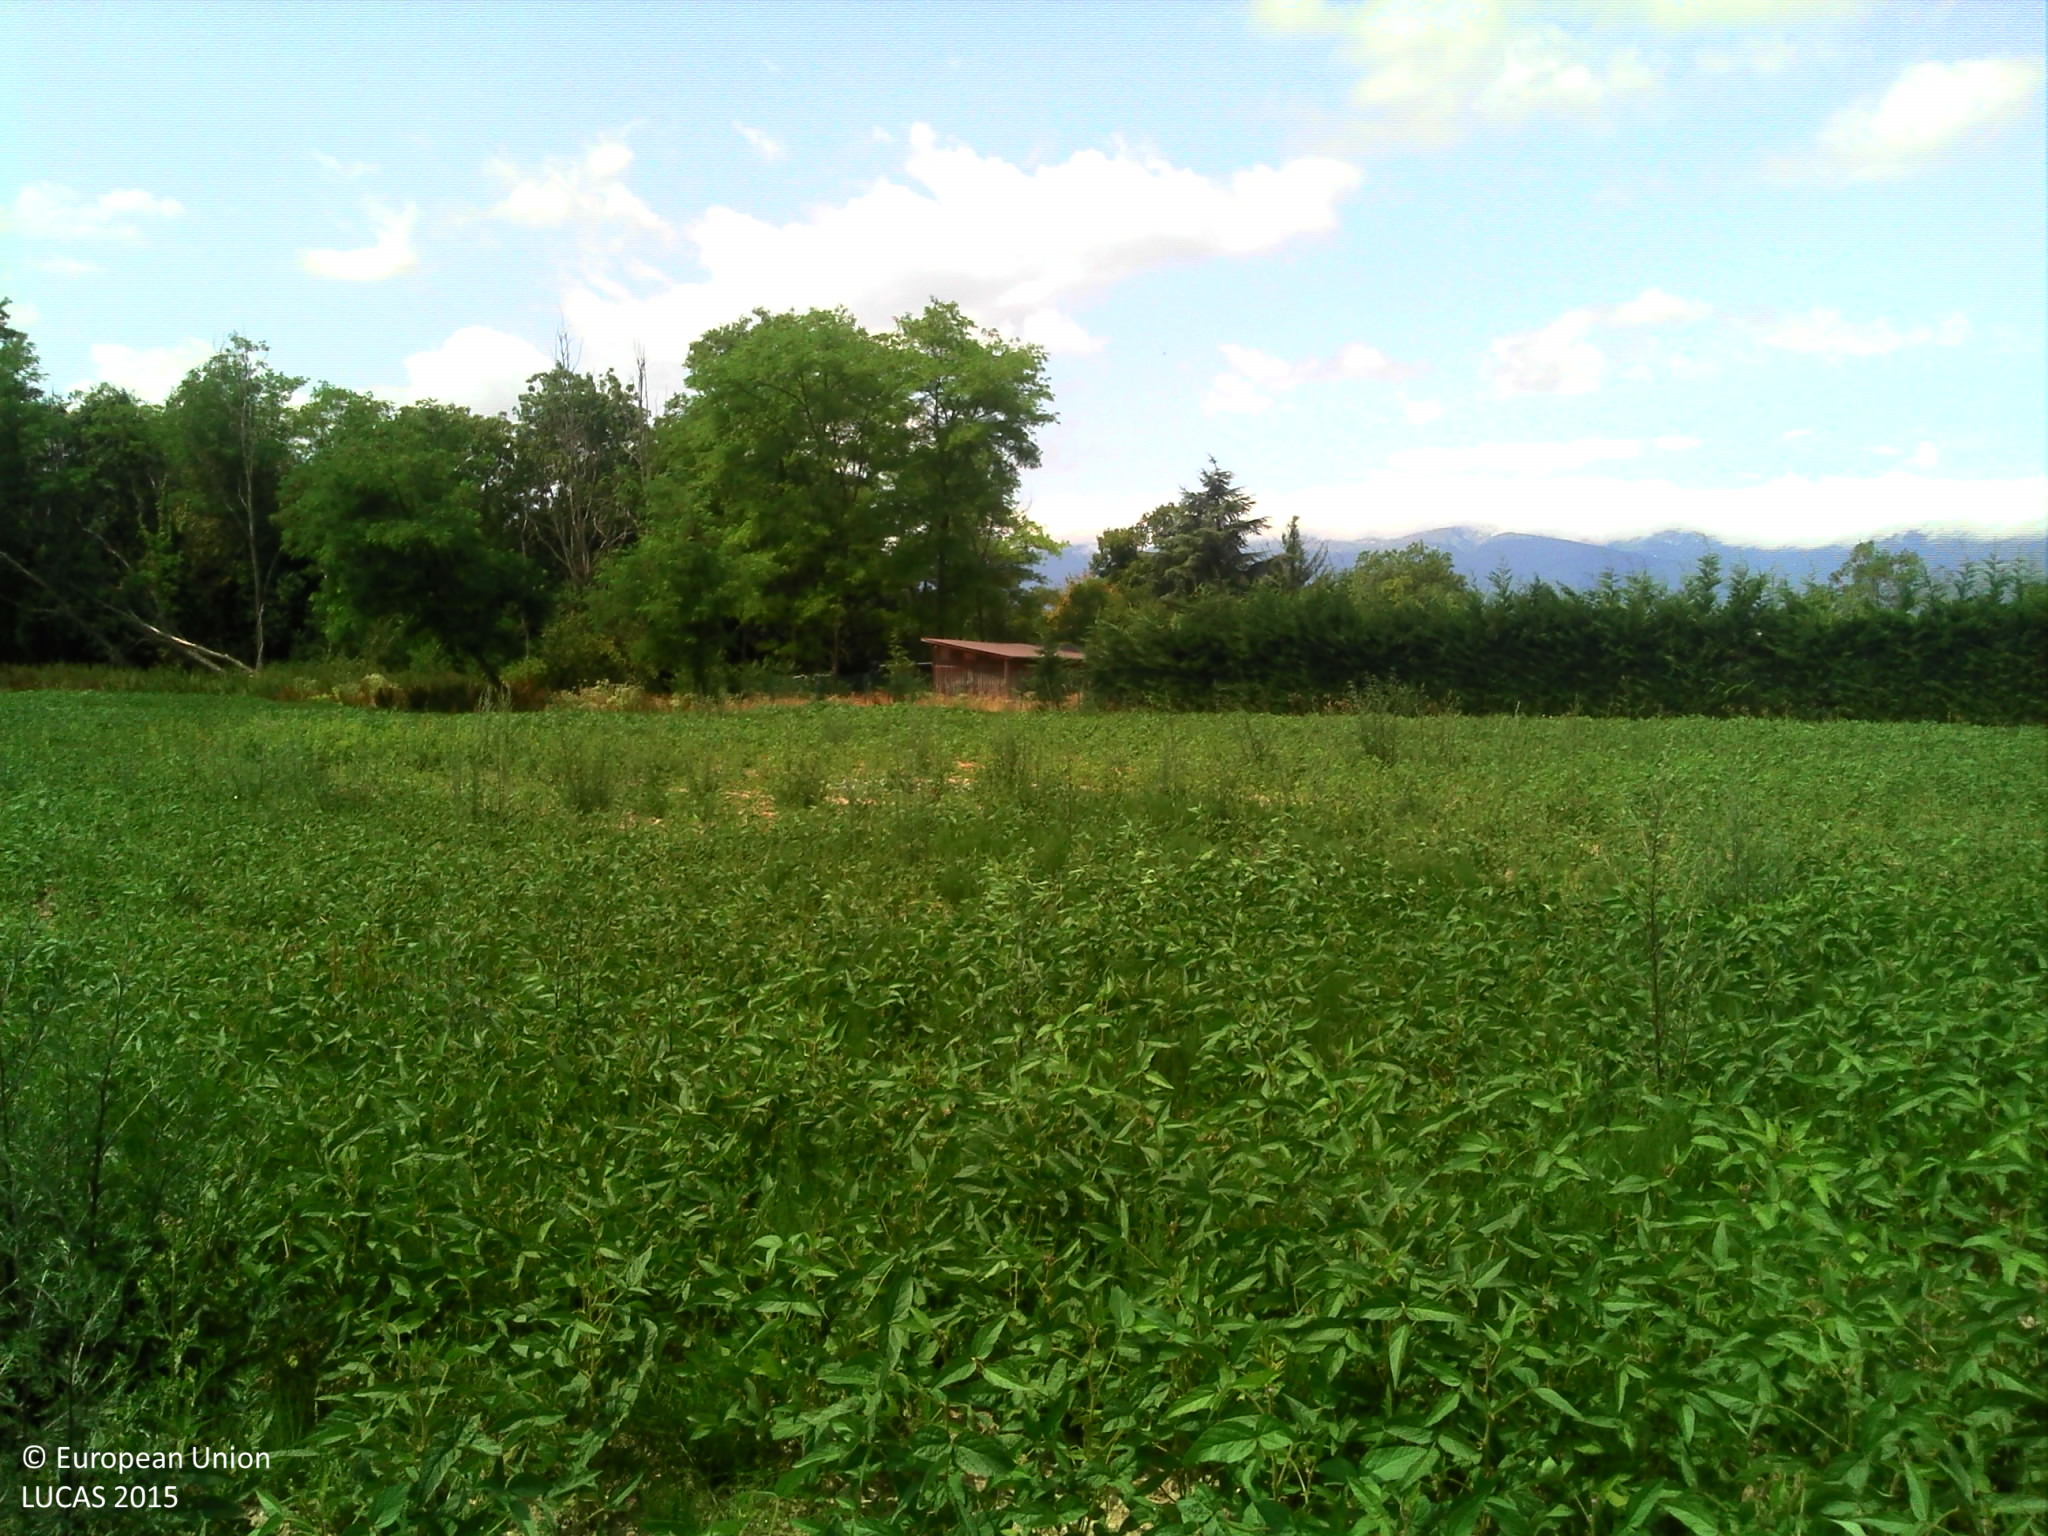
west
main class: Cropland
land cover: Soya
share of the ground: > 75 %
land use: Agriculture (excluding fallow land and kitchen gardens)
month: July
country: FR
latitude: 46.3036
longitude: 6.2510
